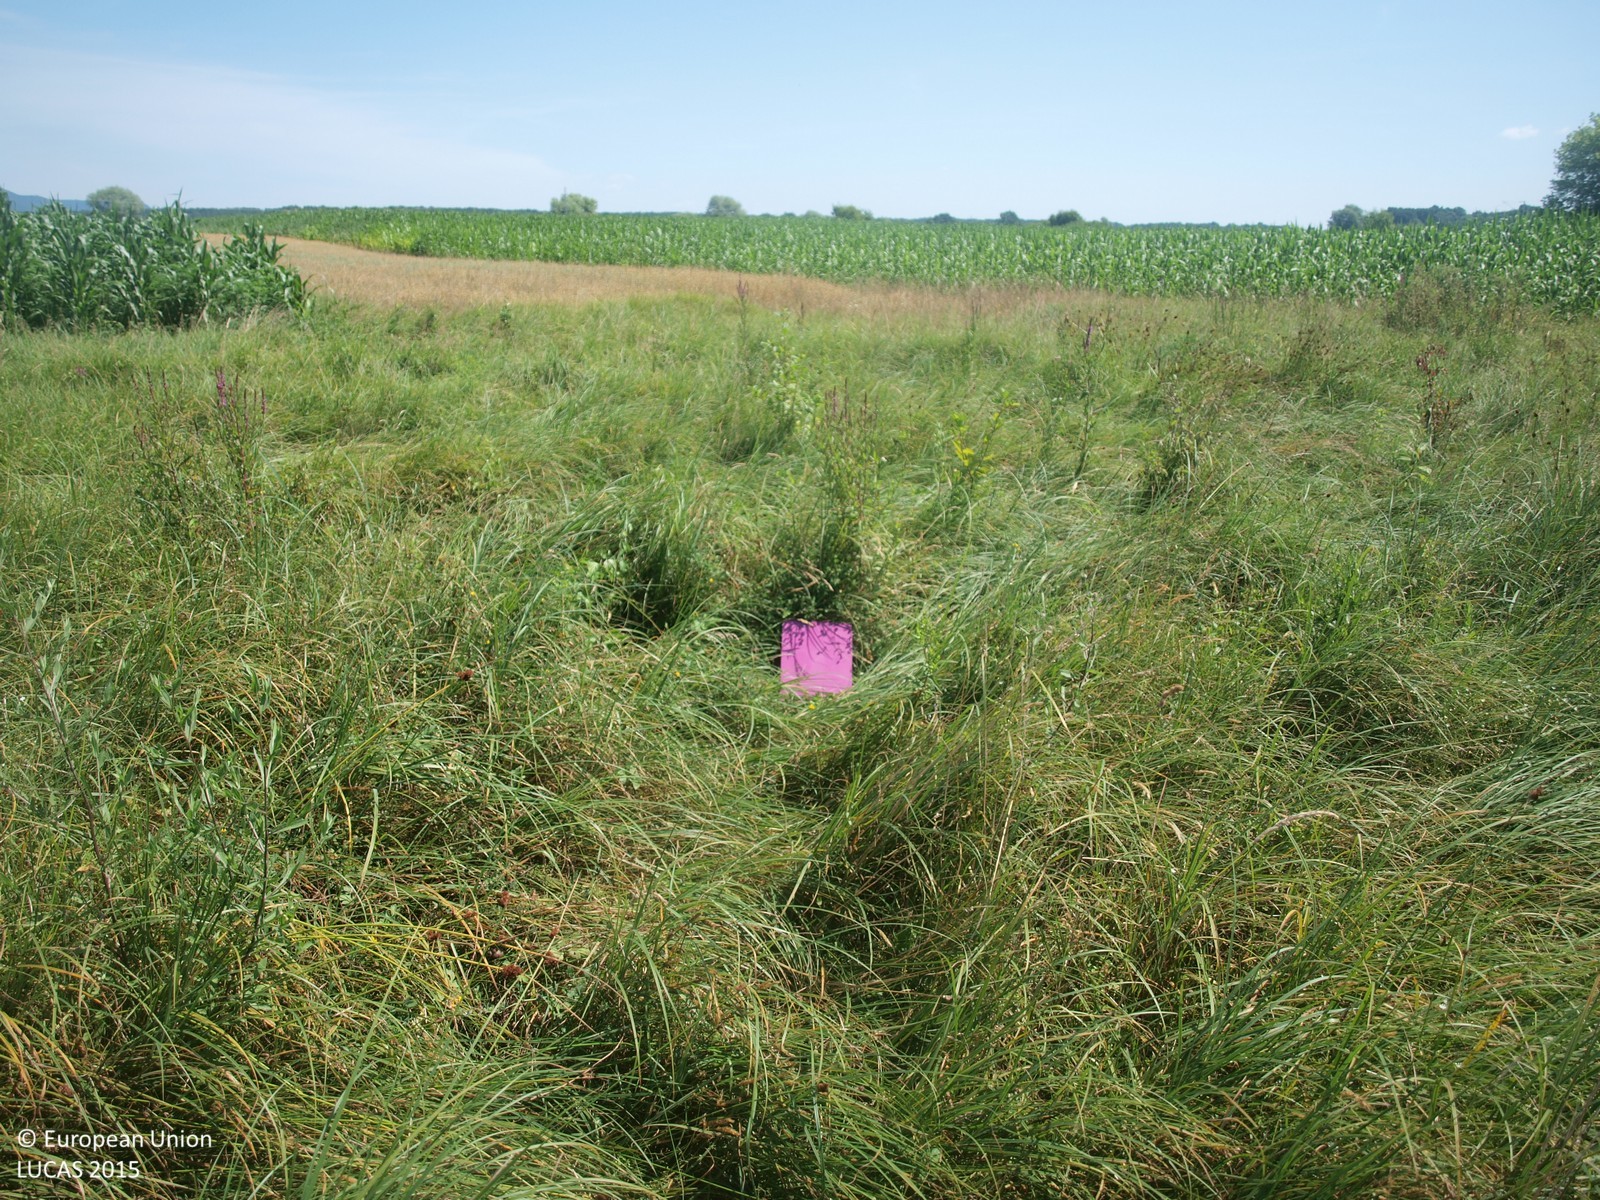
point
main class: Grassland
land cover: Grassland without tree/shrub cover
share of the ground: > 75 %
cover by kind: herbaceous plants 100 %
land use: Agriculture (excluding fallow land and kitchen gardens)
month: July
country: HR
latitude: 45.6598
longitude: 15.6567
